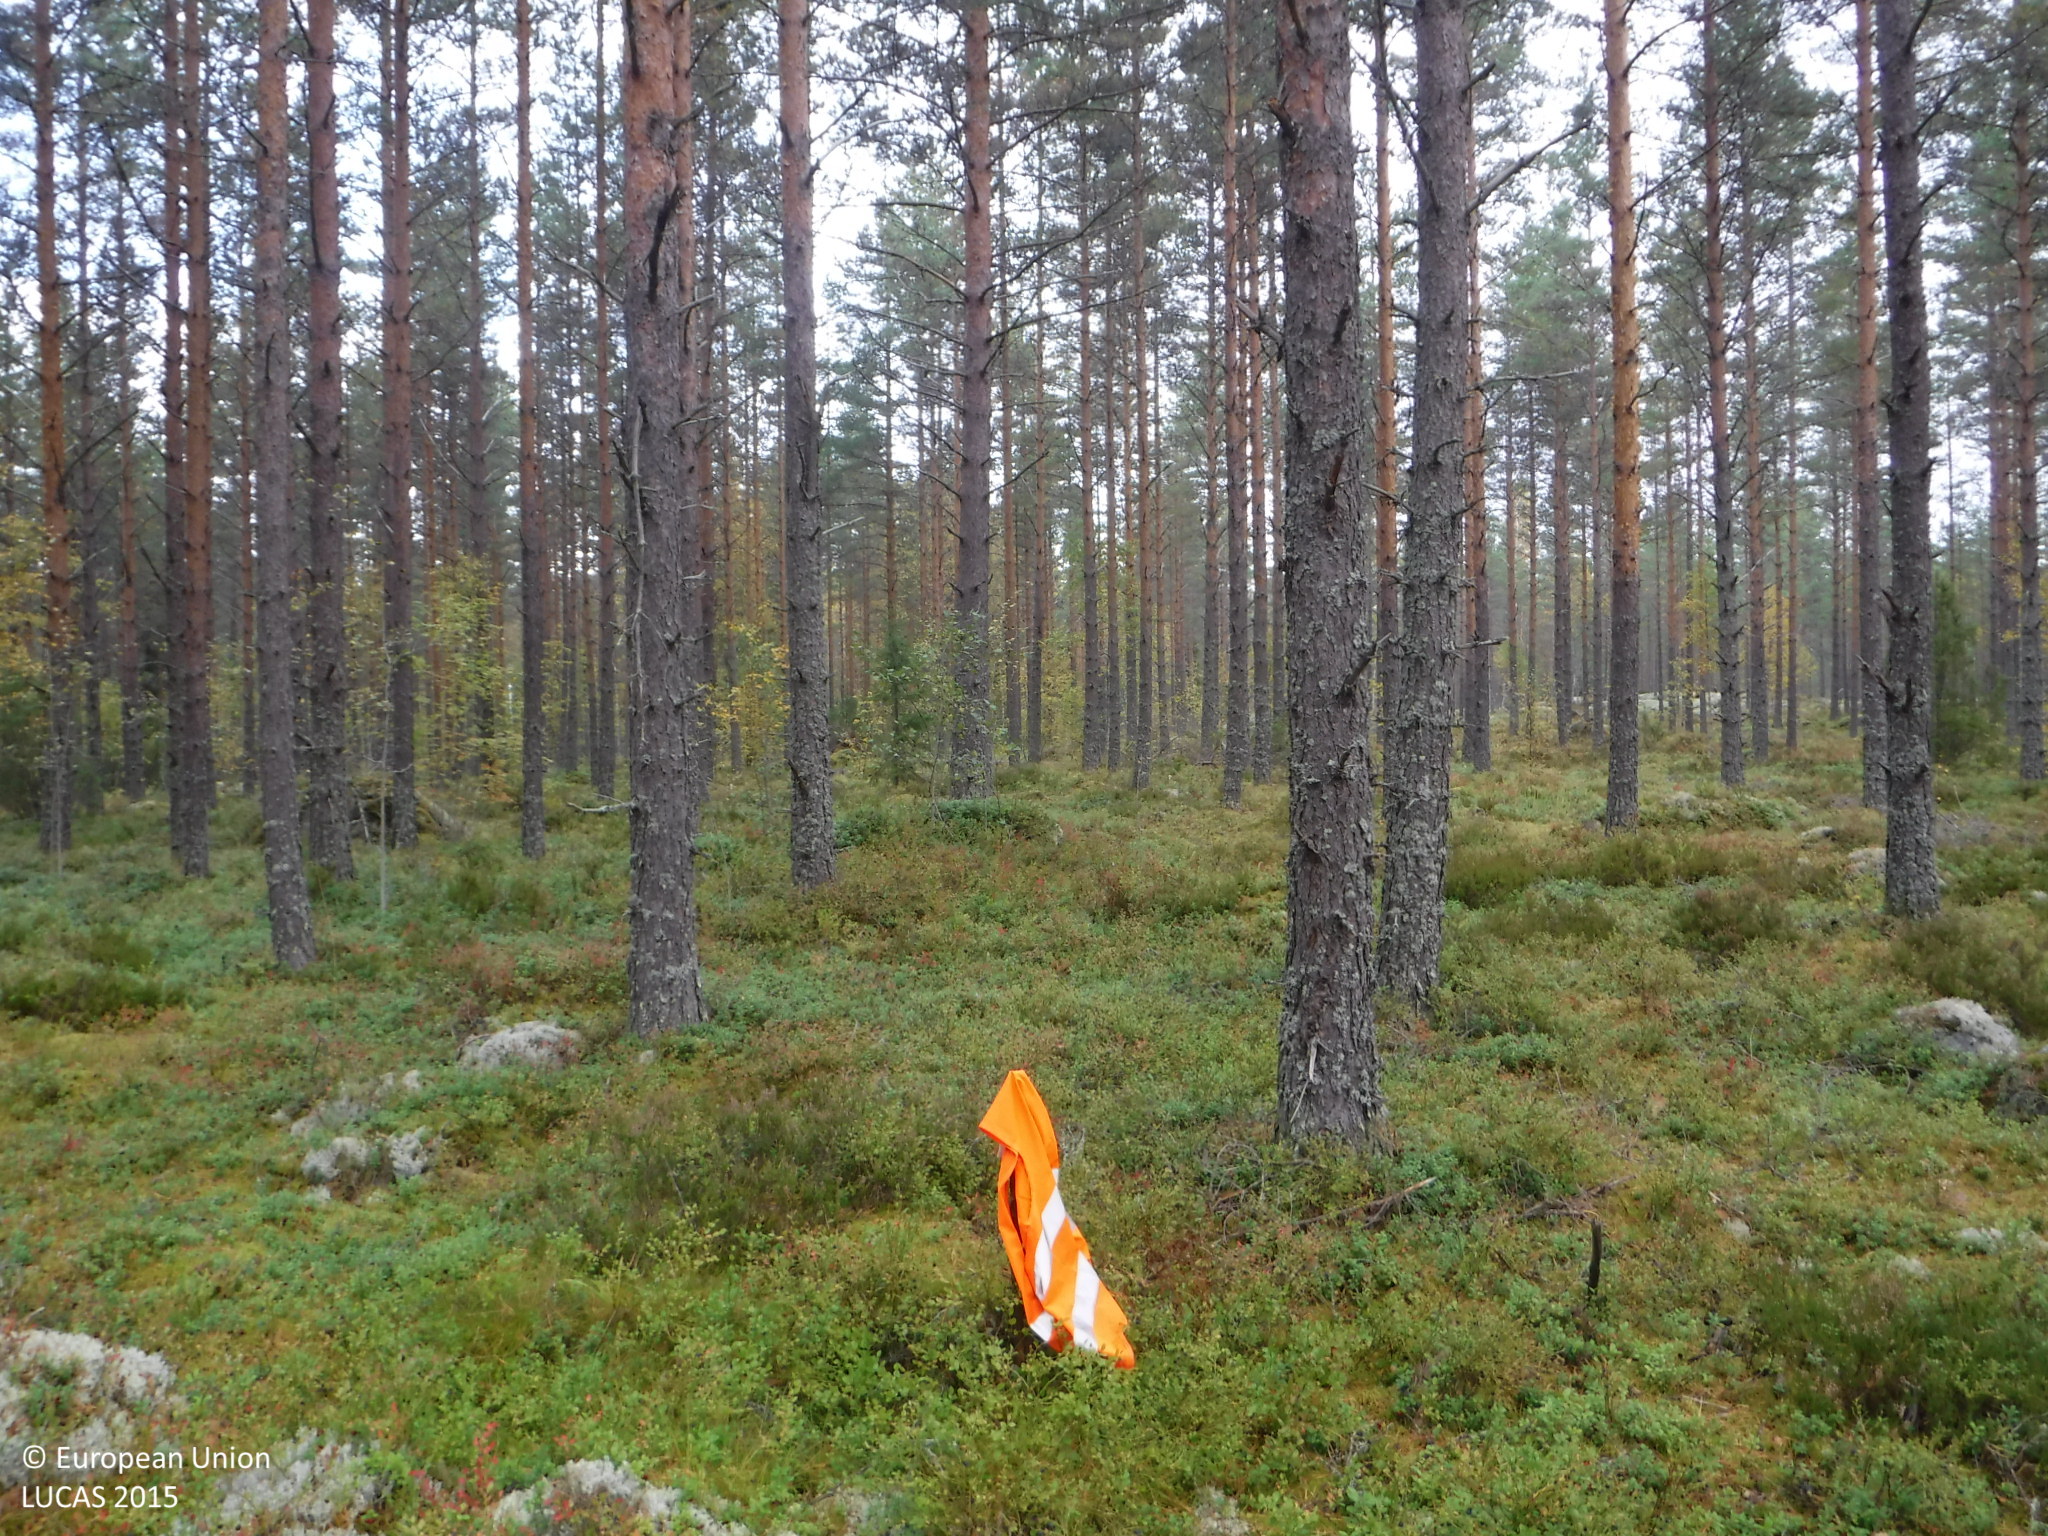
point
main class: Woodland
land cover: Pine dominated coniferous woodland
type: boreal forest
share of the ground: 25 - 50 %
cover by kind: coniferous forest trees 45 %, shrubs 30 %, lichens and mosses 25 %
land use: Forestry
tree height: > 5 m
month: September
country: FI
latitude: 61.9435
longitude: 22.2735
